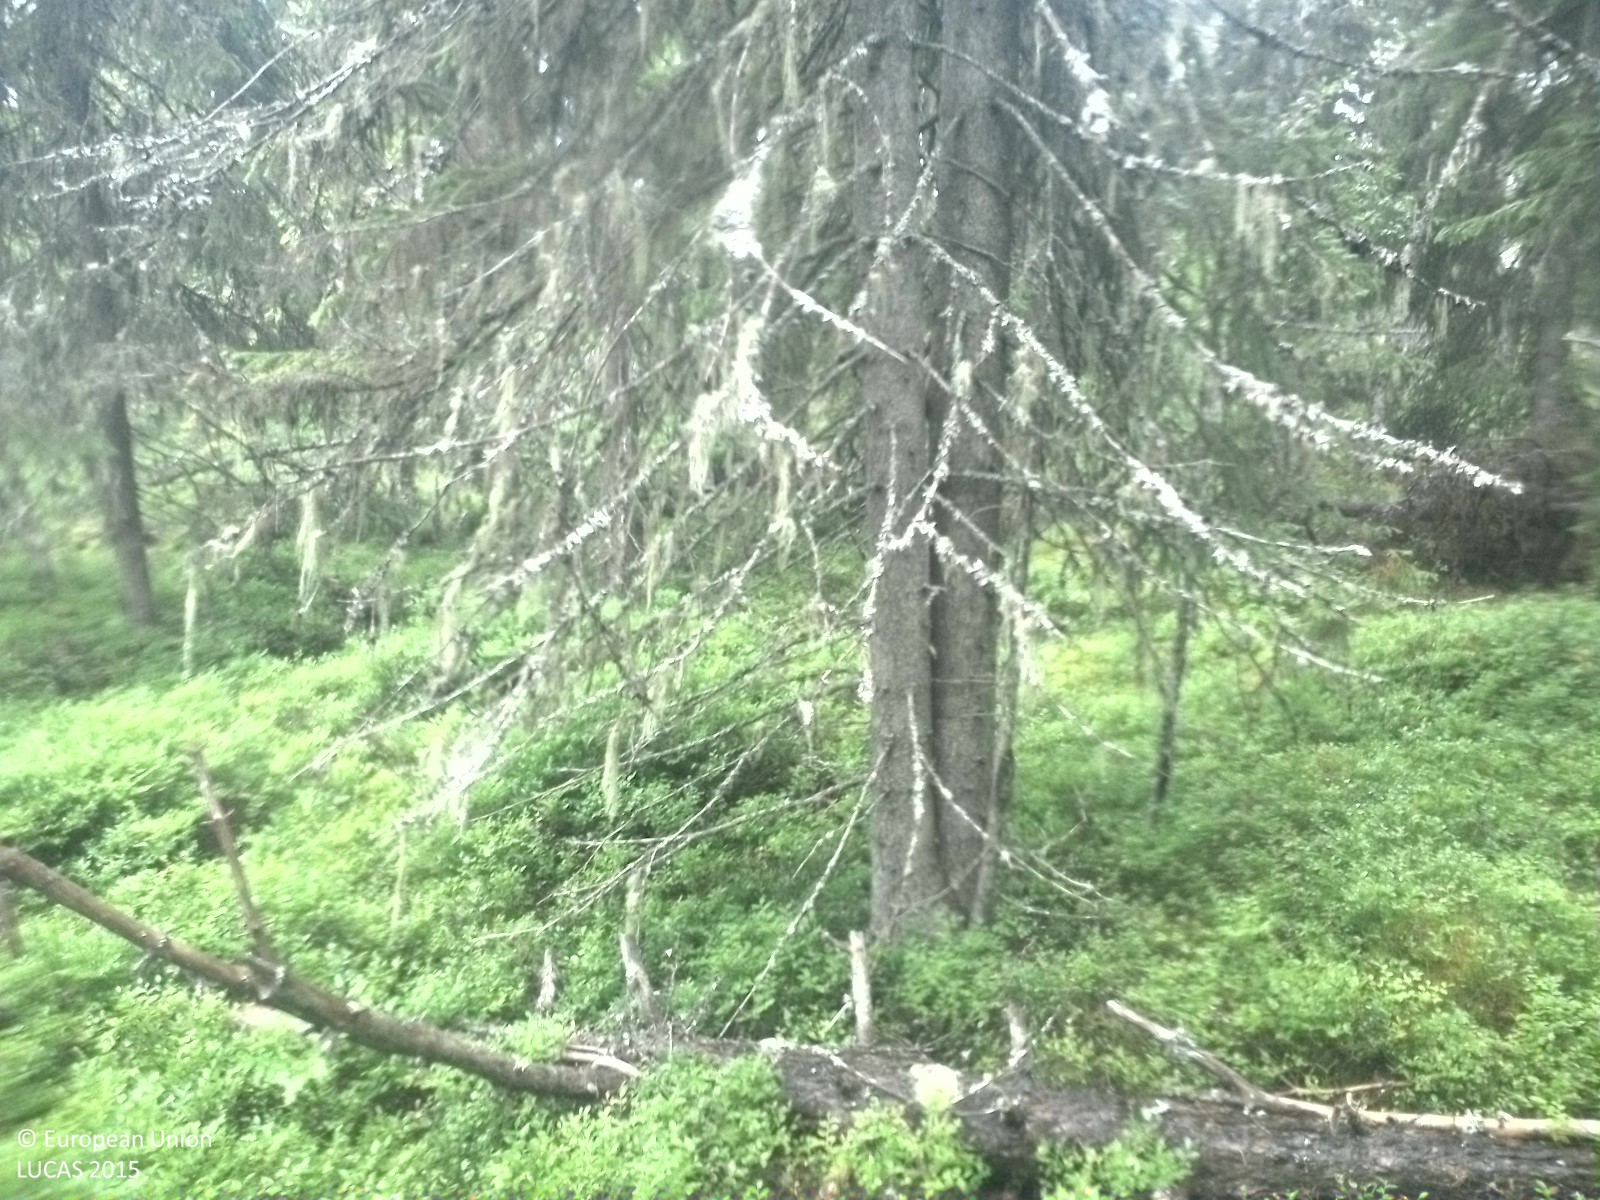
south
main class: Woodland
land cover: Spruce dominated coniferous woodland
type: boreal forest
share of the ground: 50 - 75 %
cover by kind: coniferous forest trees 55 %, shrubs 40 %, broadleaved forest trees 5 %
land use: Forestry
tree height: > 5 m
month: August
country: SE
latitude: 62.2643
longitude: 16.2786
